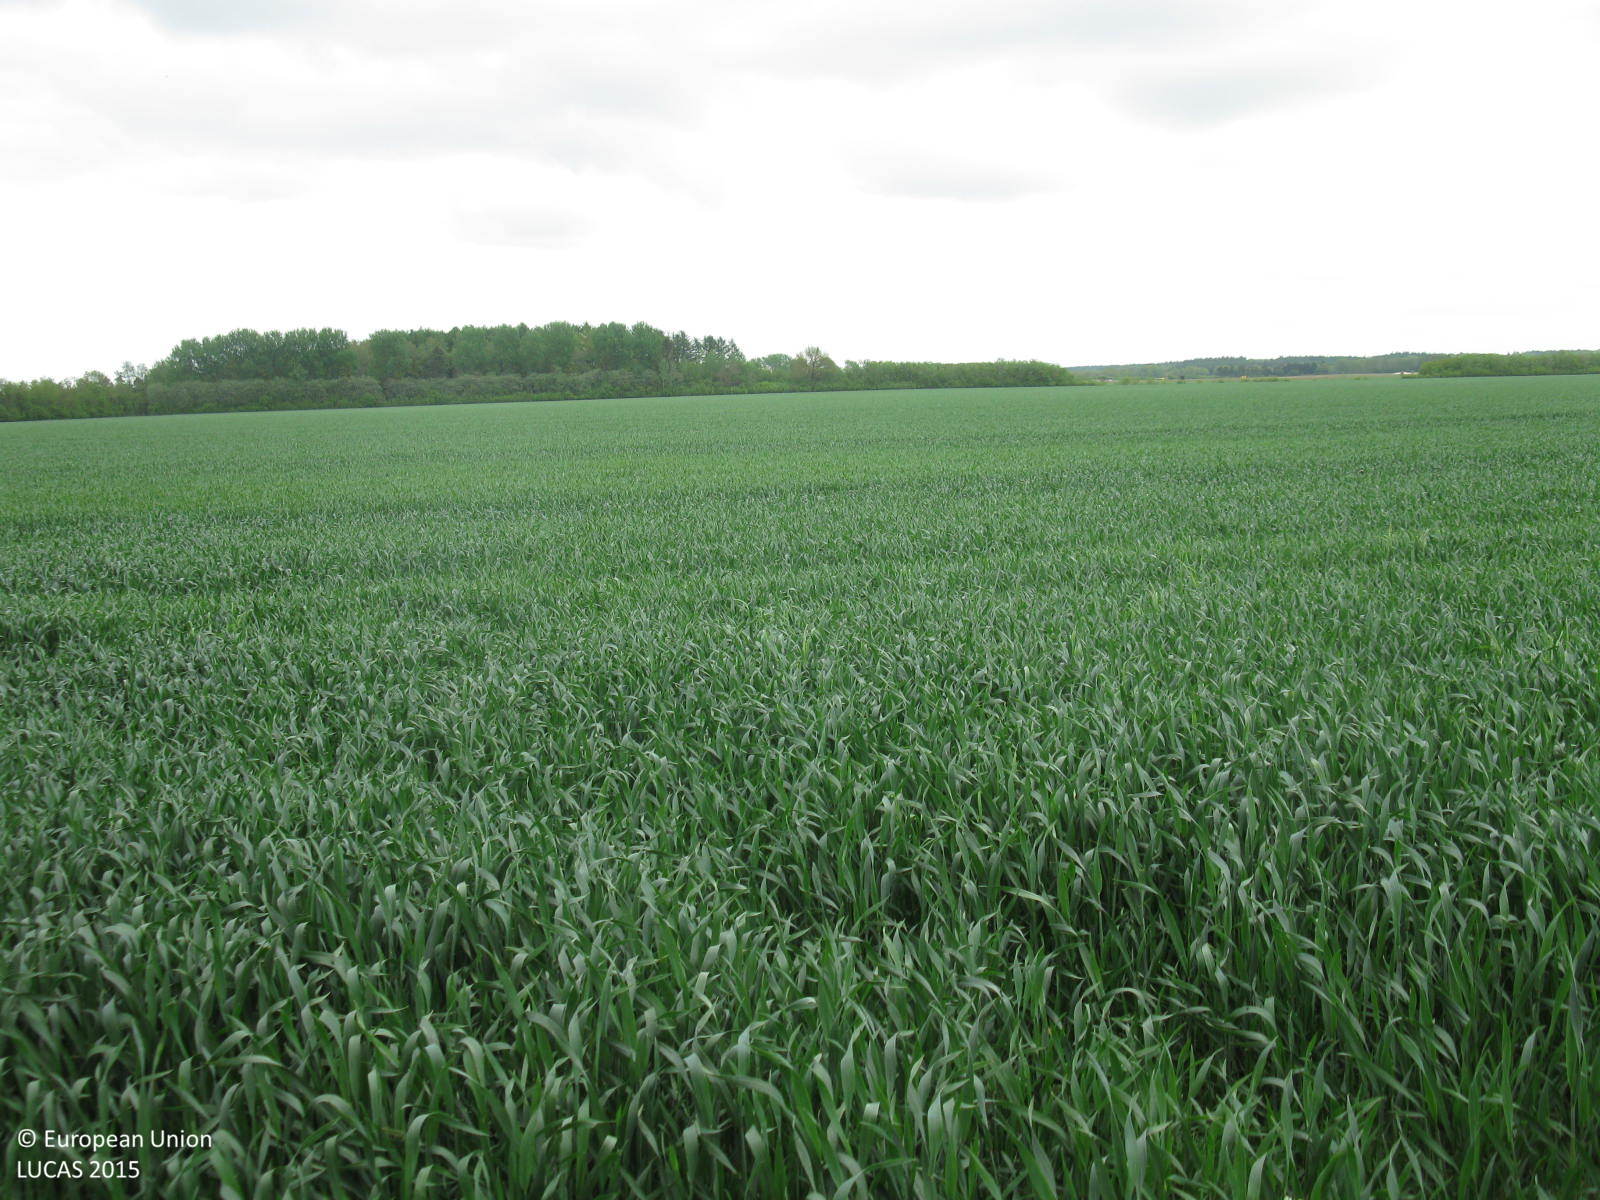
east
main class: Cropland
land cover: Triticale
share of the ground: > 75 %
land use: Agriculture (excluding fallow land and kitchen gardens)
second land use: Community services
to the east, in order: Triticale; Broadleaved woodland; Grassland without tree/shrub cover; Ditches and canals; Grassland without tree/shrub cover; Tracks; Arable land (only in case pi)
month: May
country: DE
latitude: 52.8706
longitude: 7.4006
